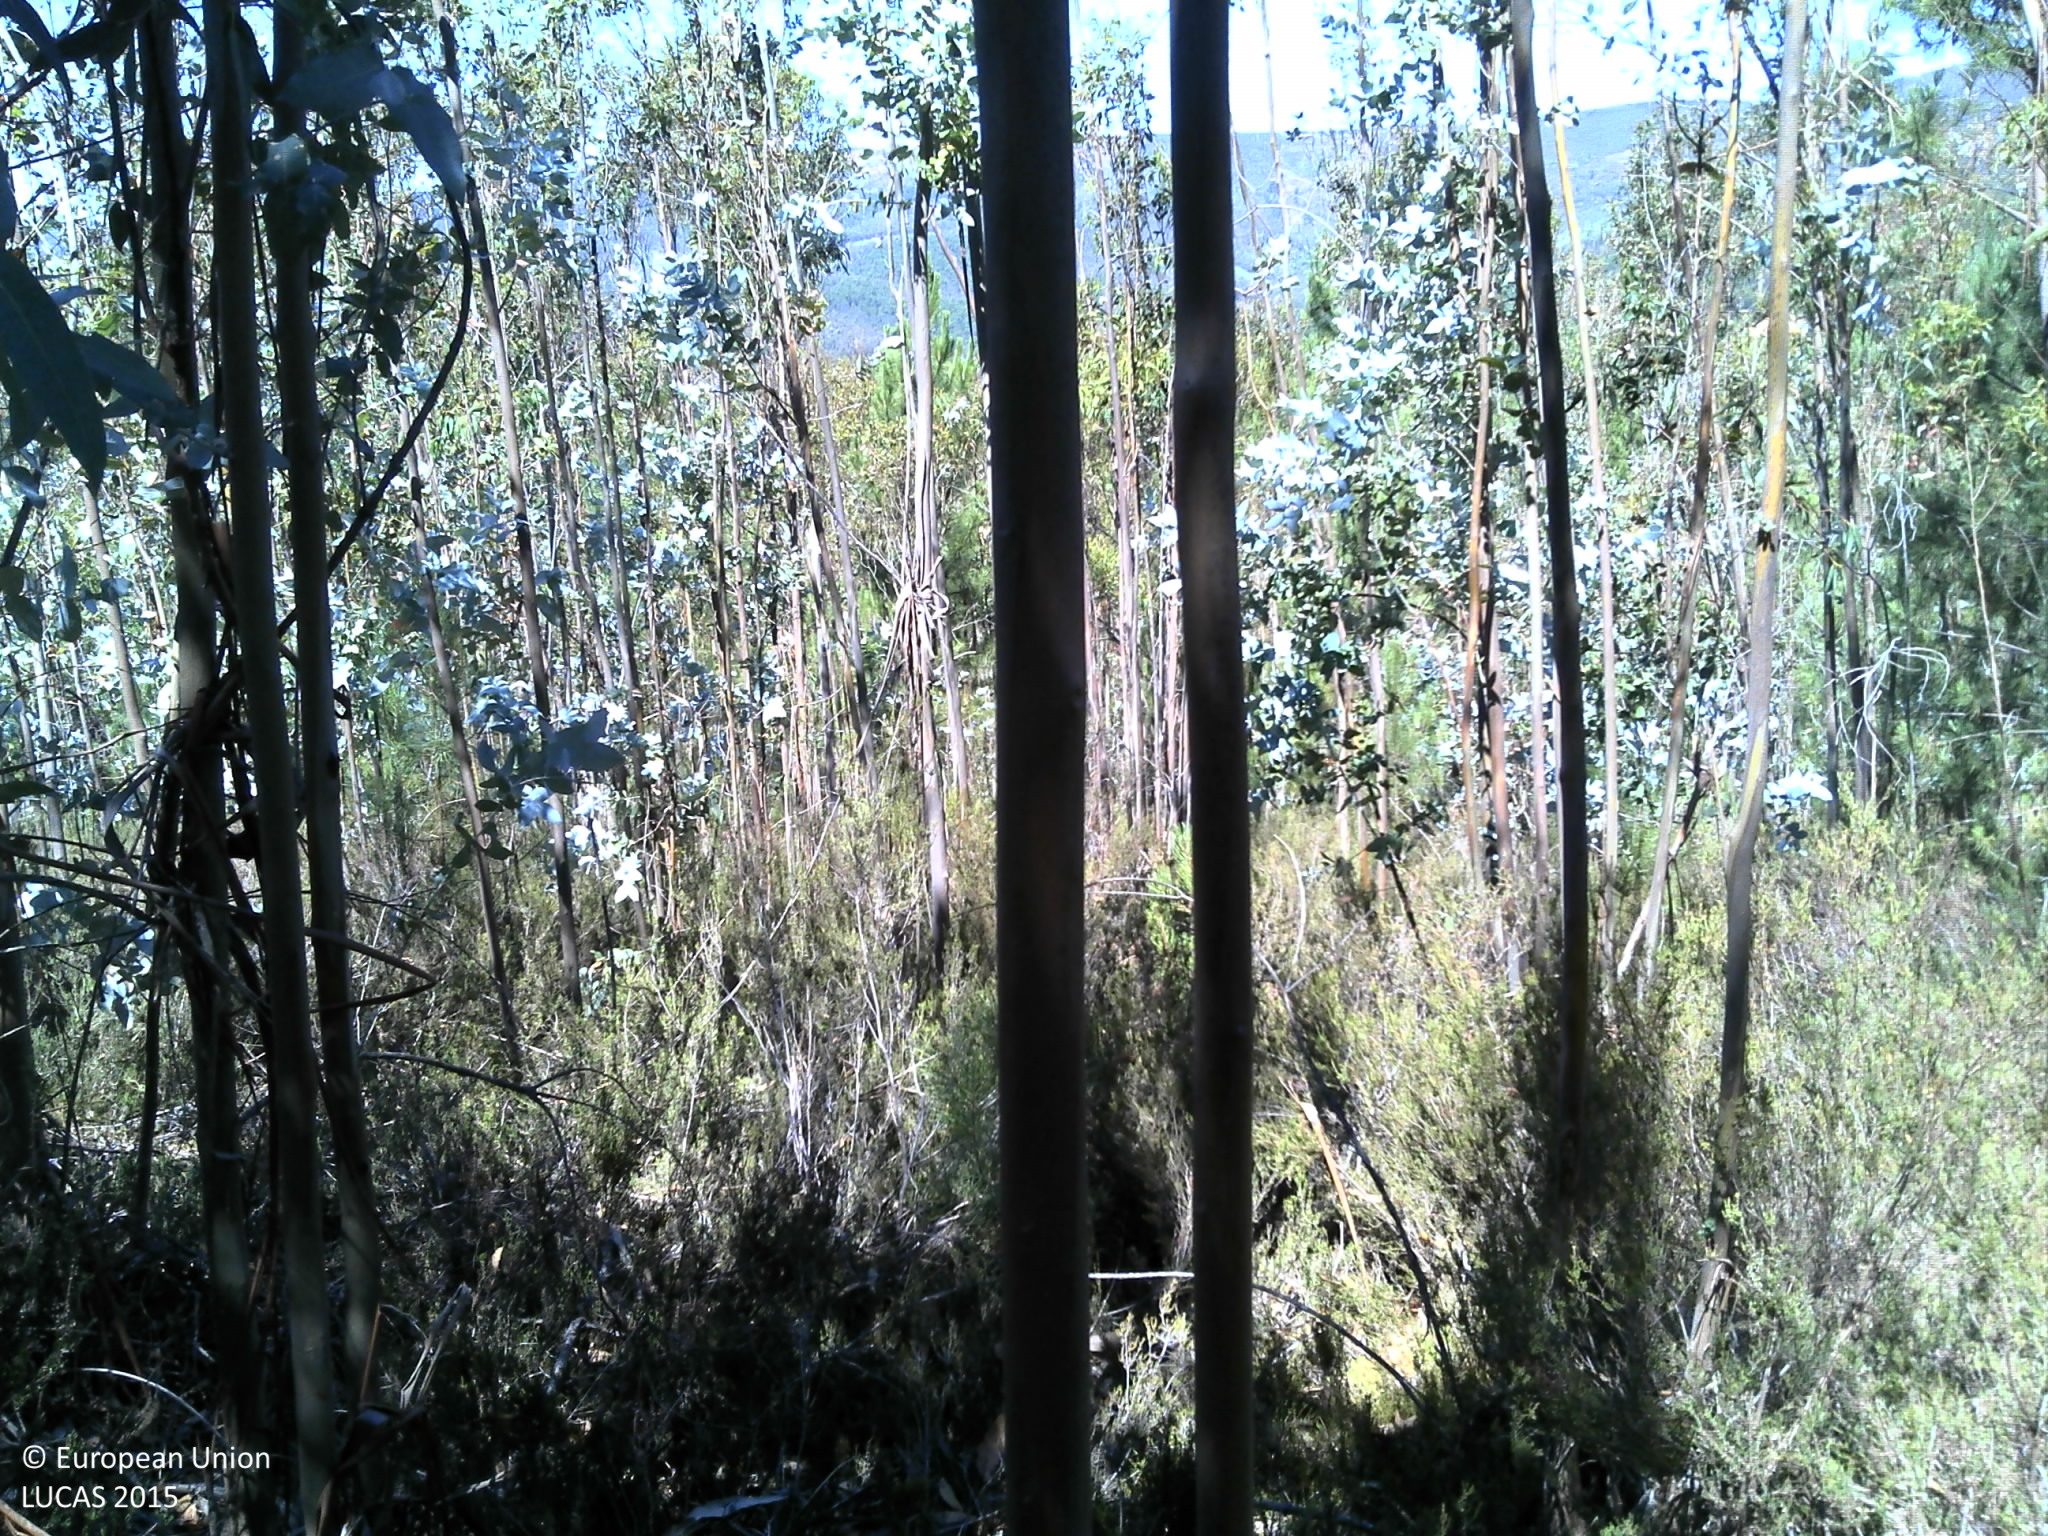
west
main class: Woodland
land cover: Broadleaved woodland
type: exotic forest
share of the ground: 10 - 25 %
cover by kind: shrubs 80 %, broadleaved forest trees 15 %, unconsolidated bare surface 5 %
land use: Forestry
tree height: > 5 m
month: July
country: PT
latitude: 40.0099
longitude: -8.1967
